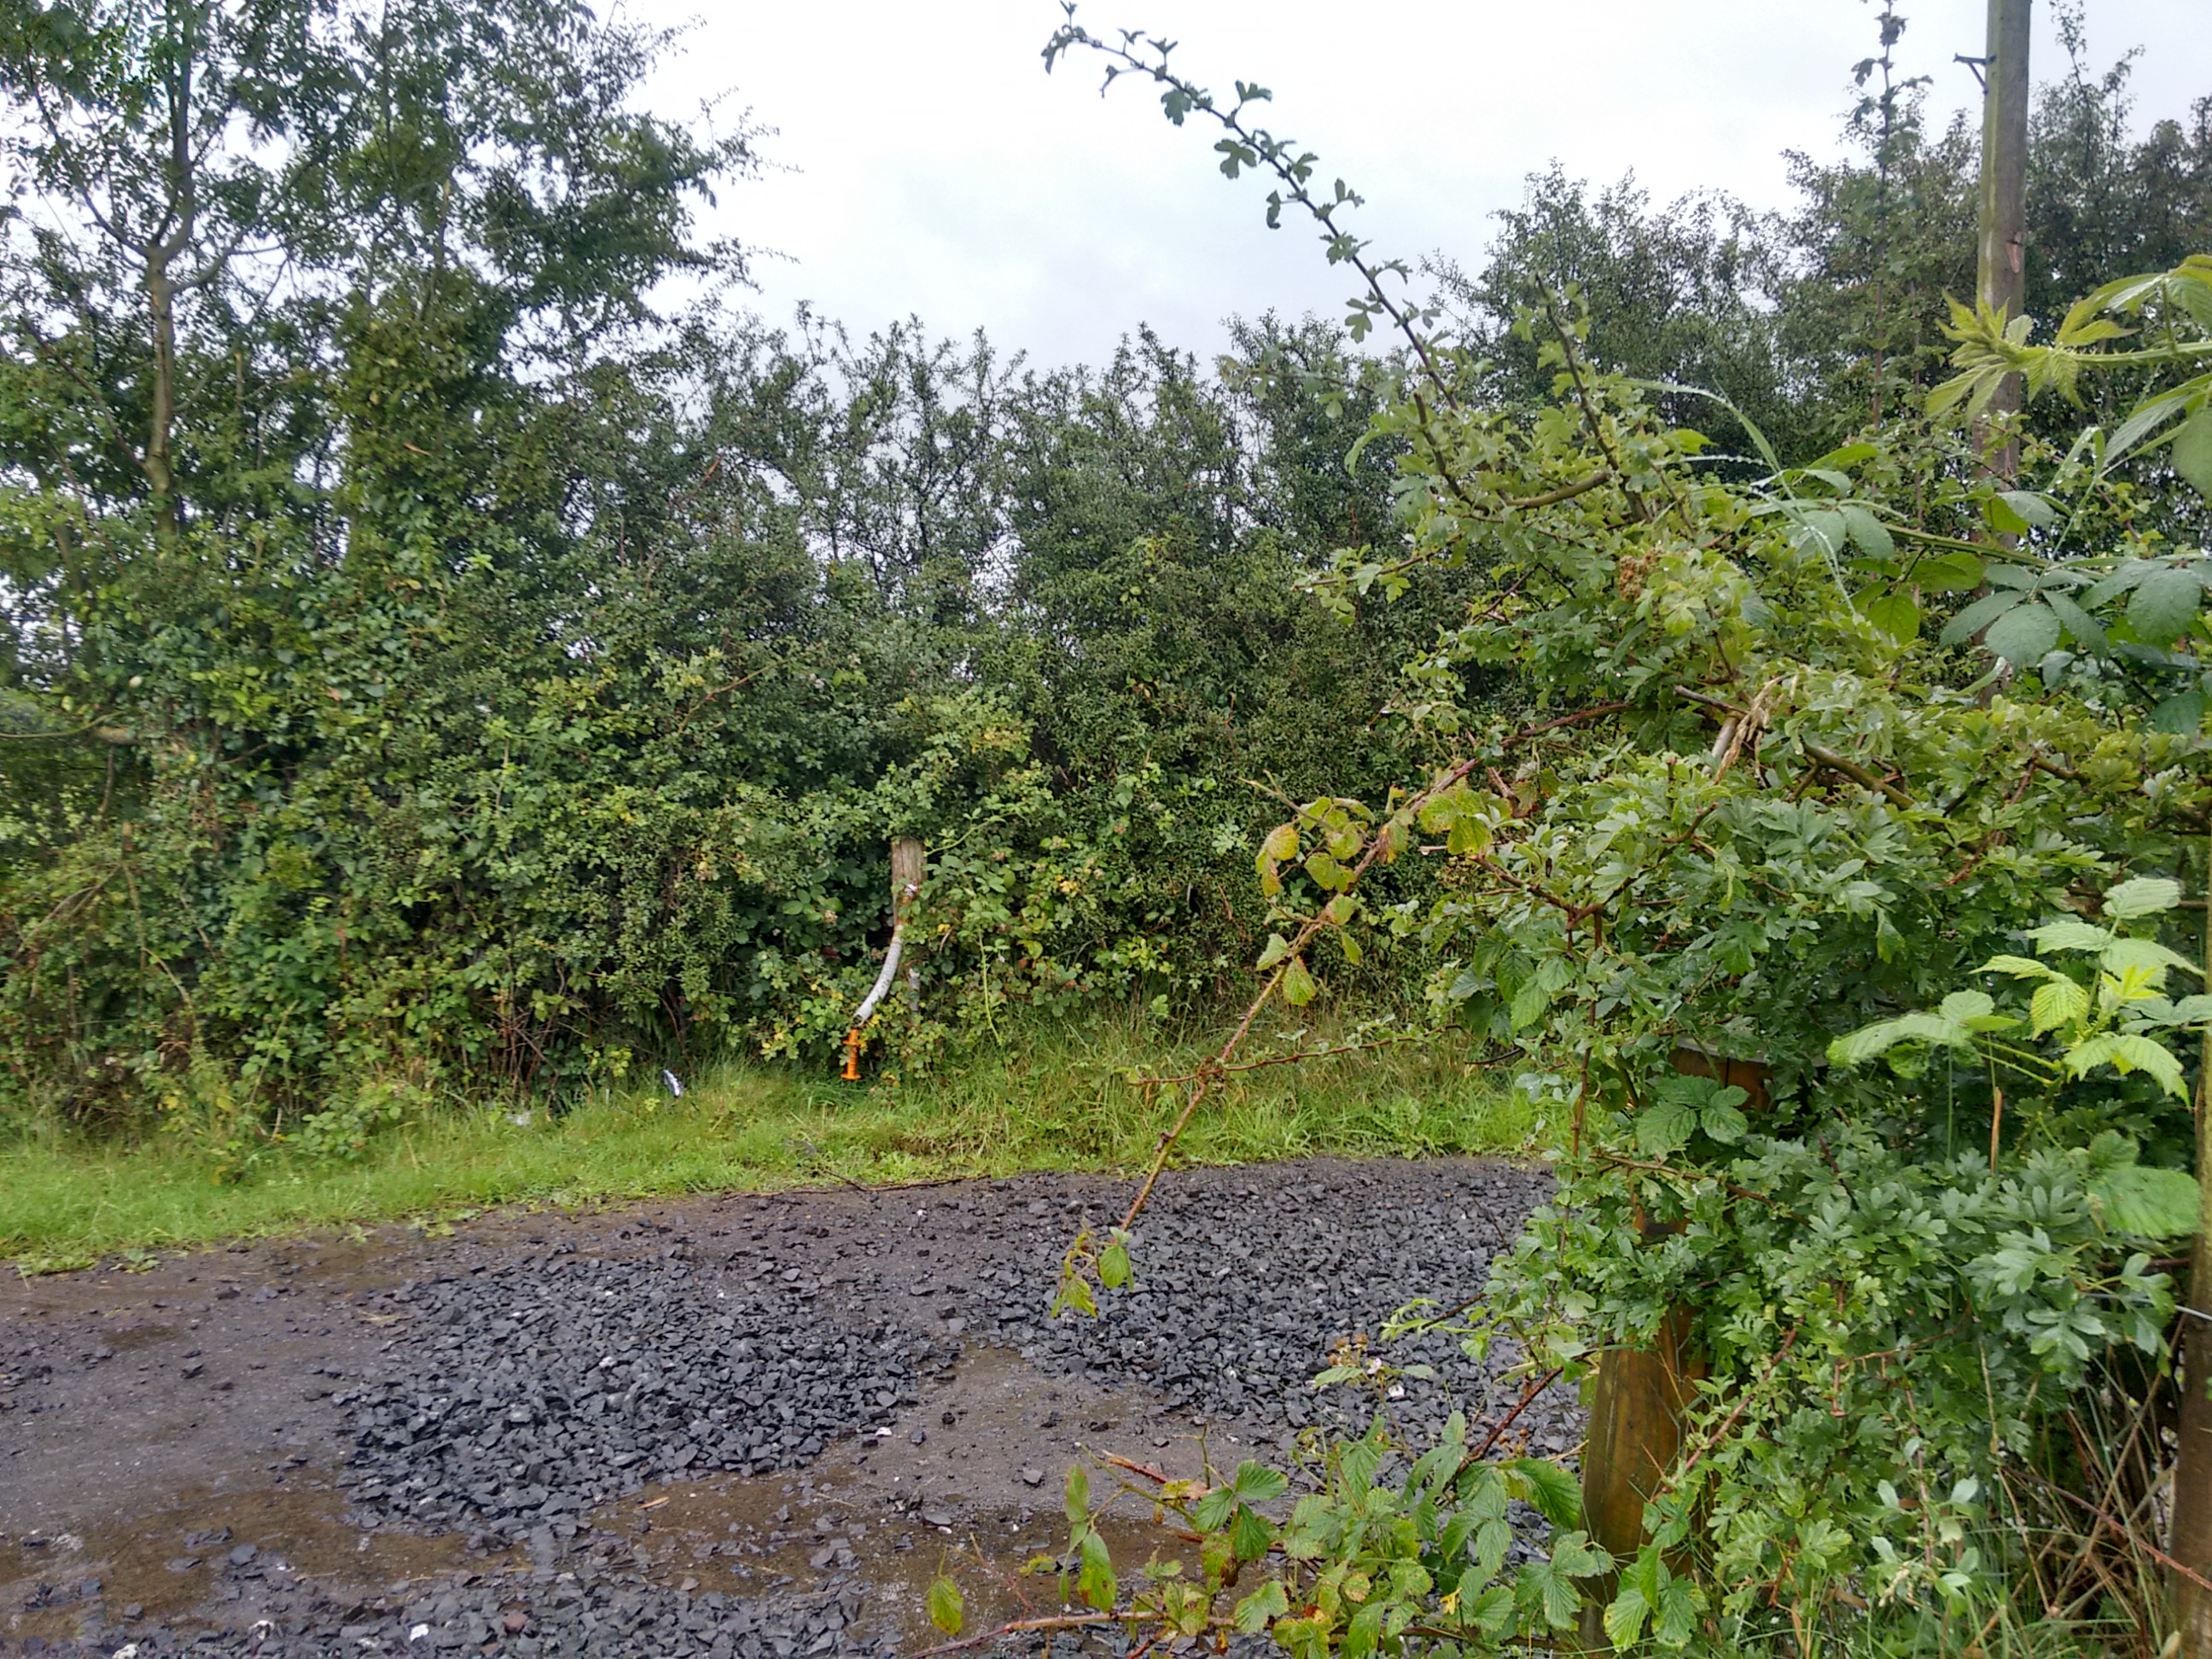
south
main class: Grassland
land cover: Grassland without tree/shrub cover
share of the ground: > 75 %
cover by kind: herbaceous plants 100 %
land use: Agriculture (excluding fallow land and kitchen gardens)
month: August
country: GB
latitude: 54.8353
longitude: -6.6144
